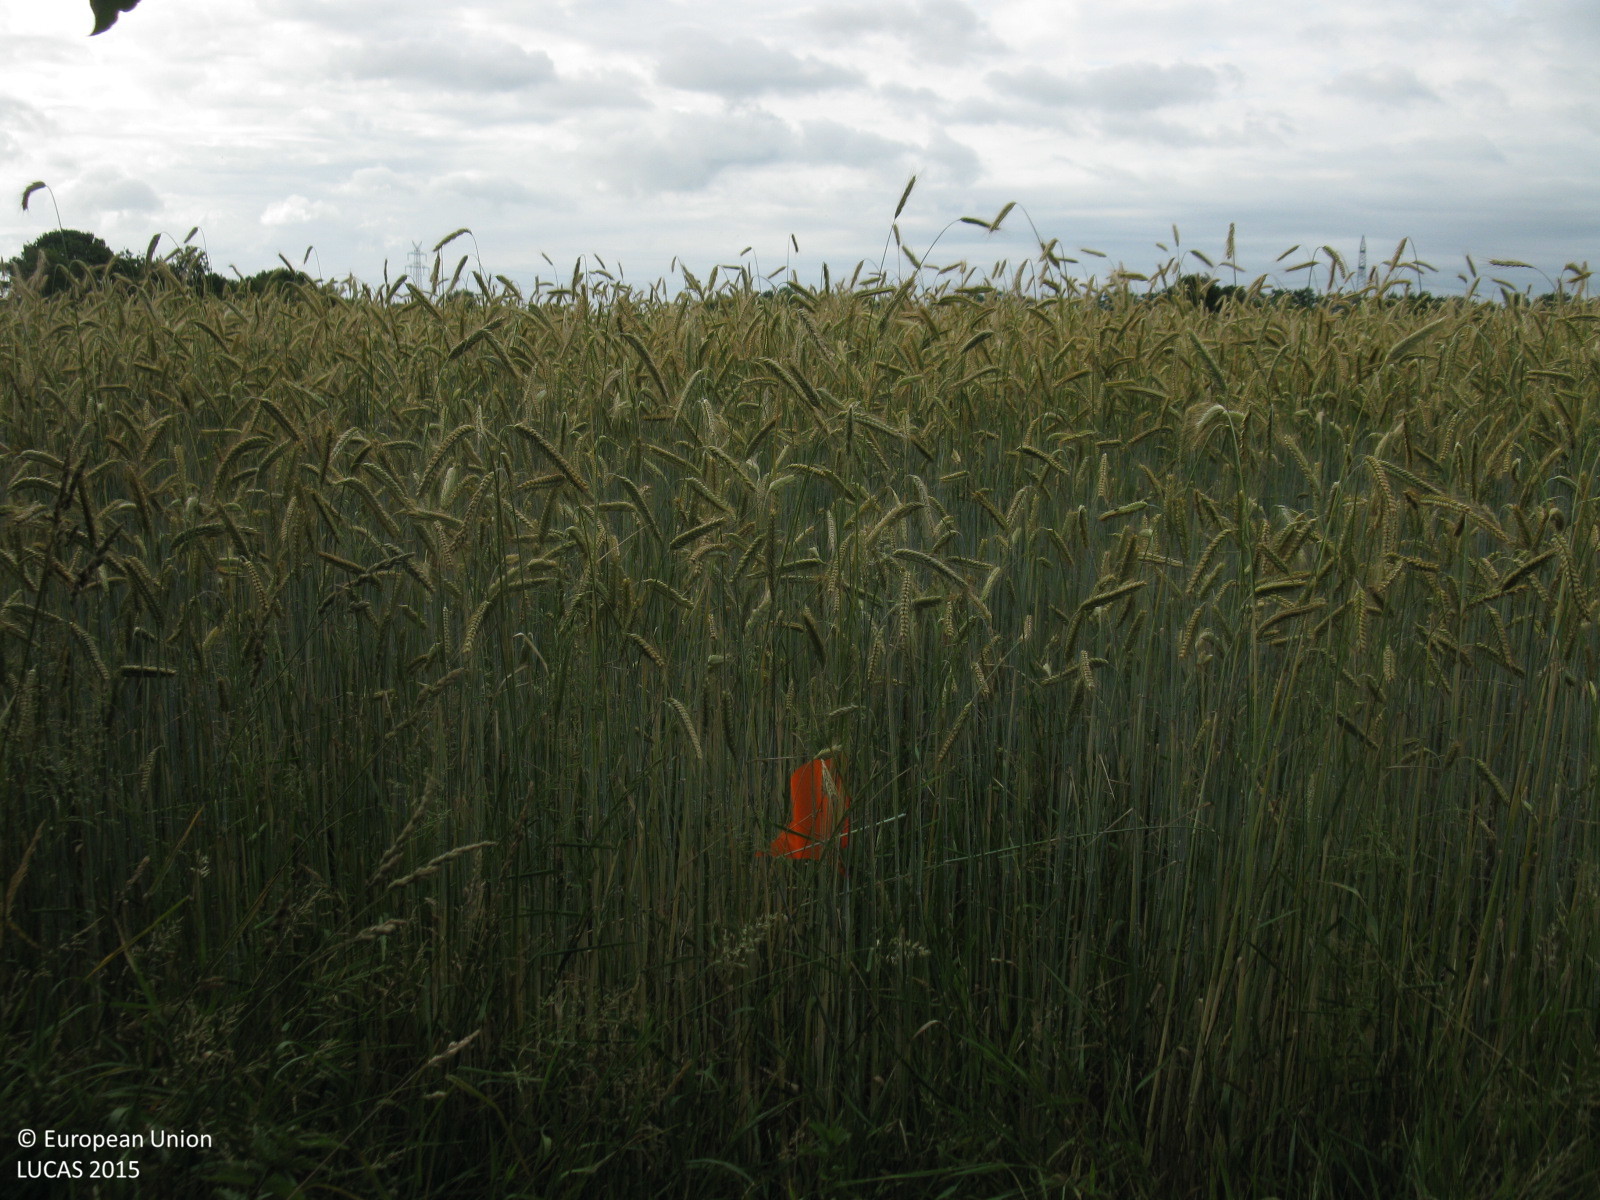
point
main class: Cropland
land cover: Rye
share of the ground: > 75 %
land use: Agriculture (excluding fallow land and kitchen gardens)
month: July
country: DE
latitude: 53.3490
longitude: 7.9727
